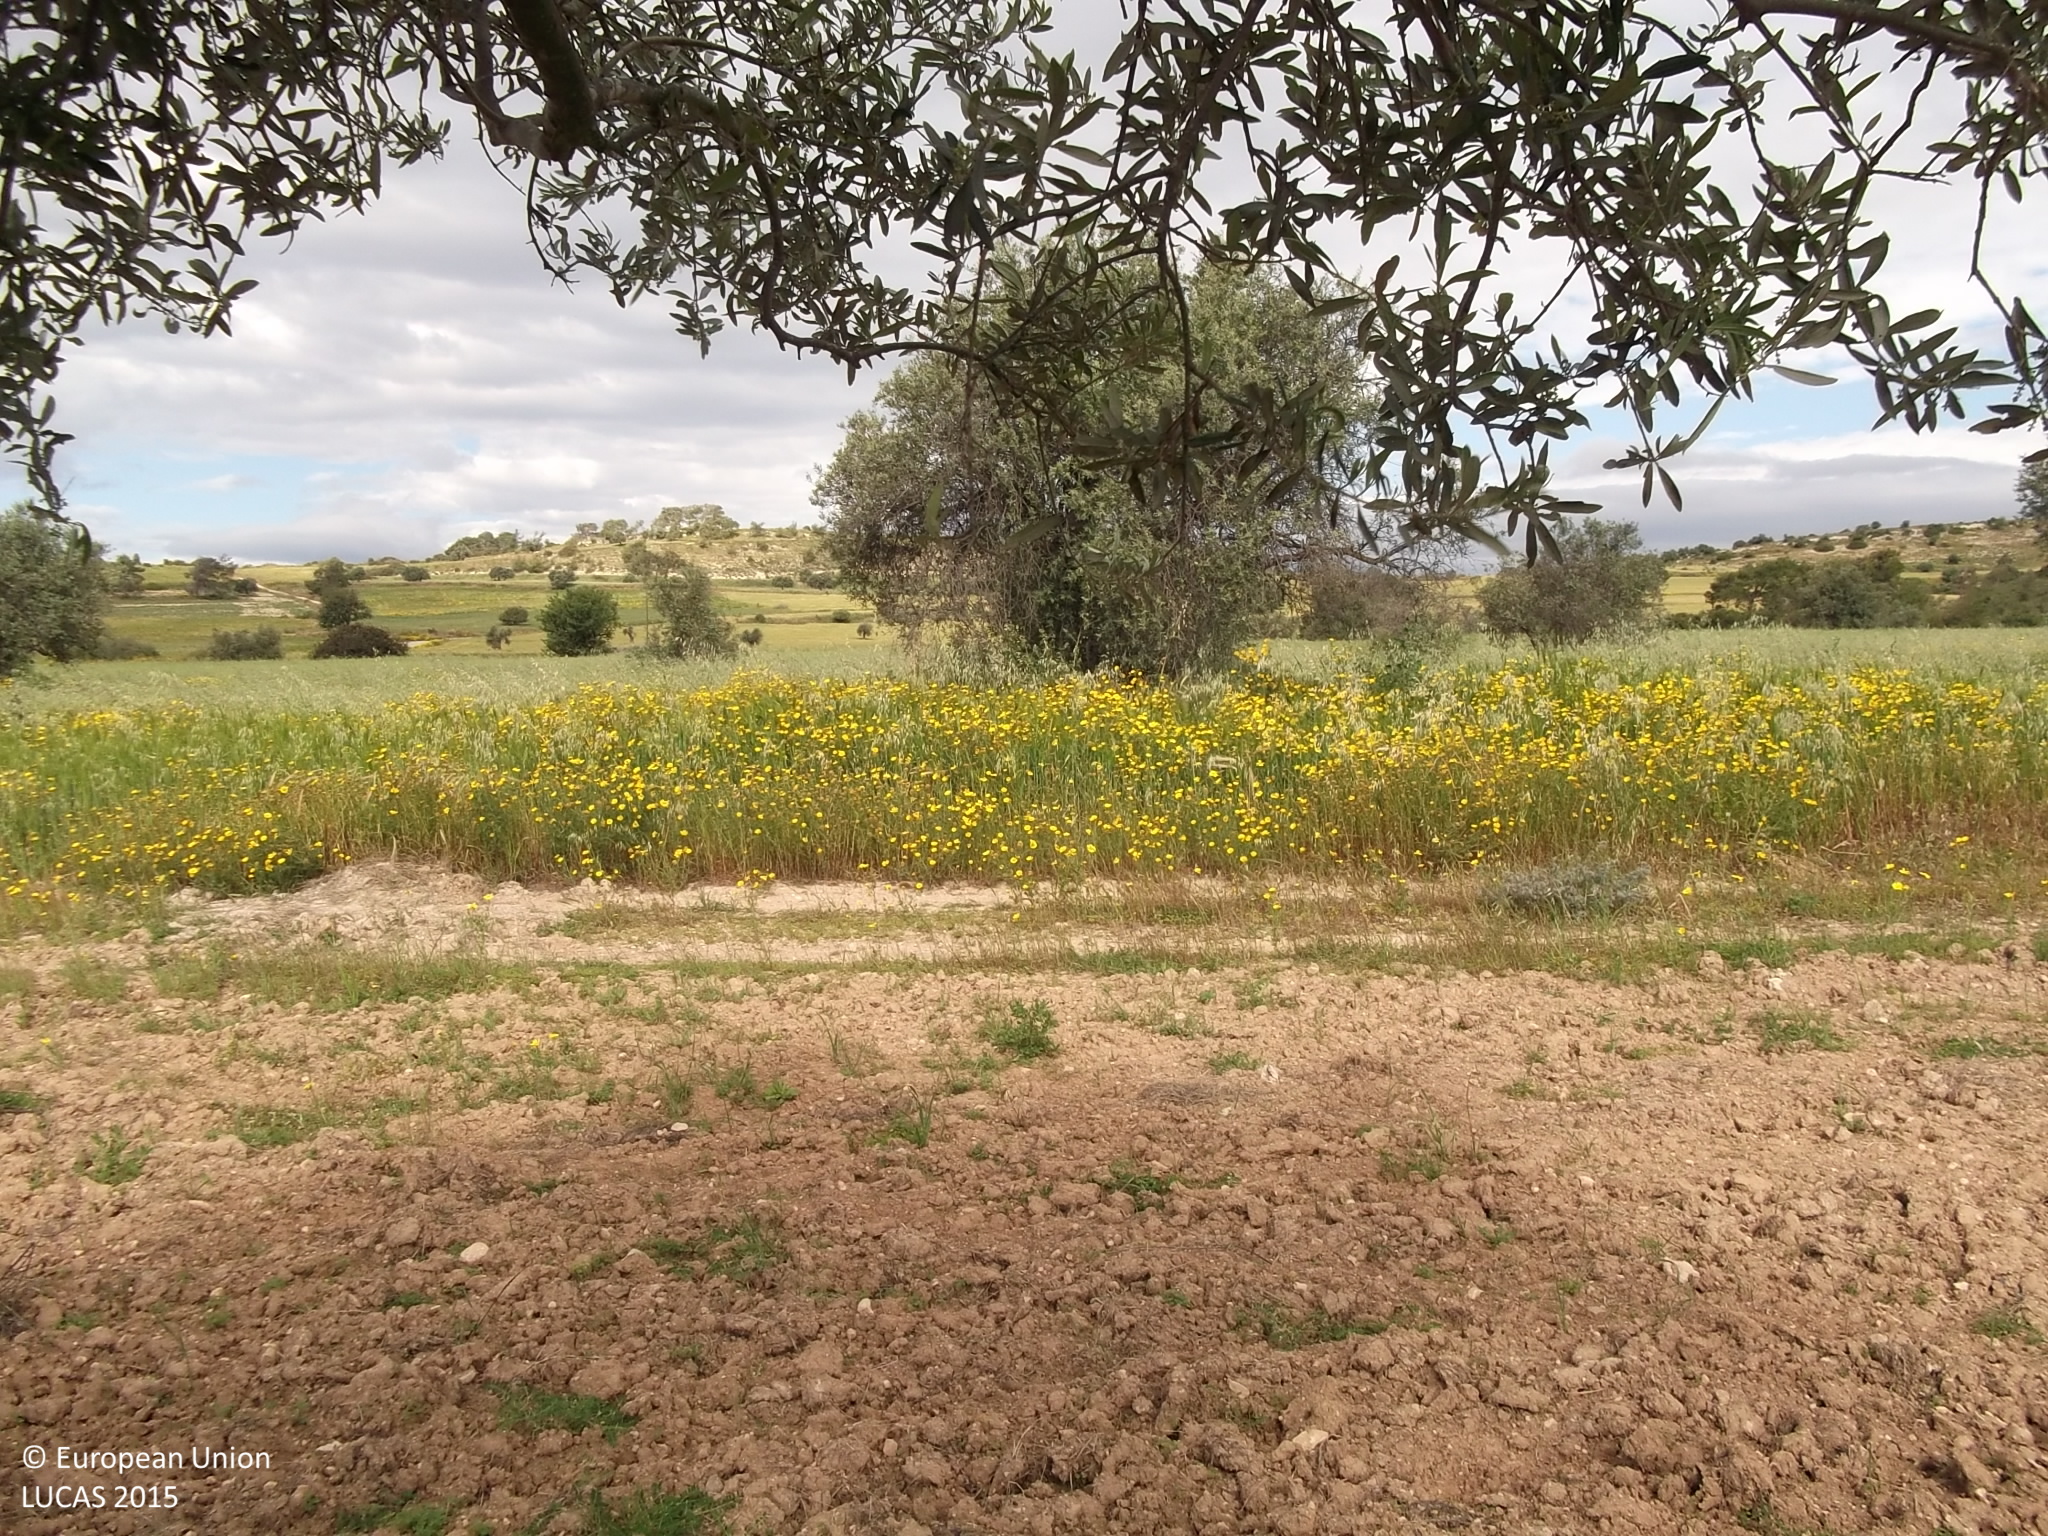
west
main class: Cropland
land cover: Olive groves
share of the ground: 25 - 50 %
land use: Agriculture (excluding fallow land and kitchen gardens)
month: April
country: CY
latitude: 34.8297
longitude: 33.4427
